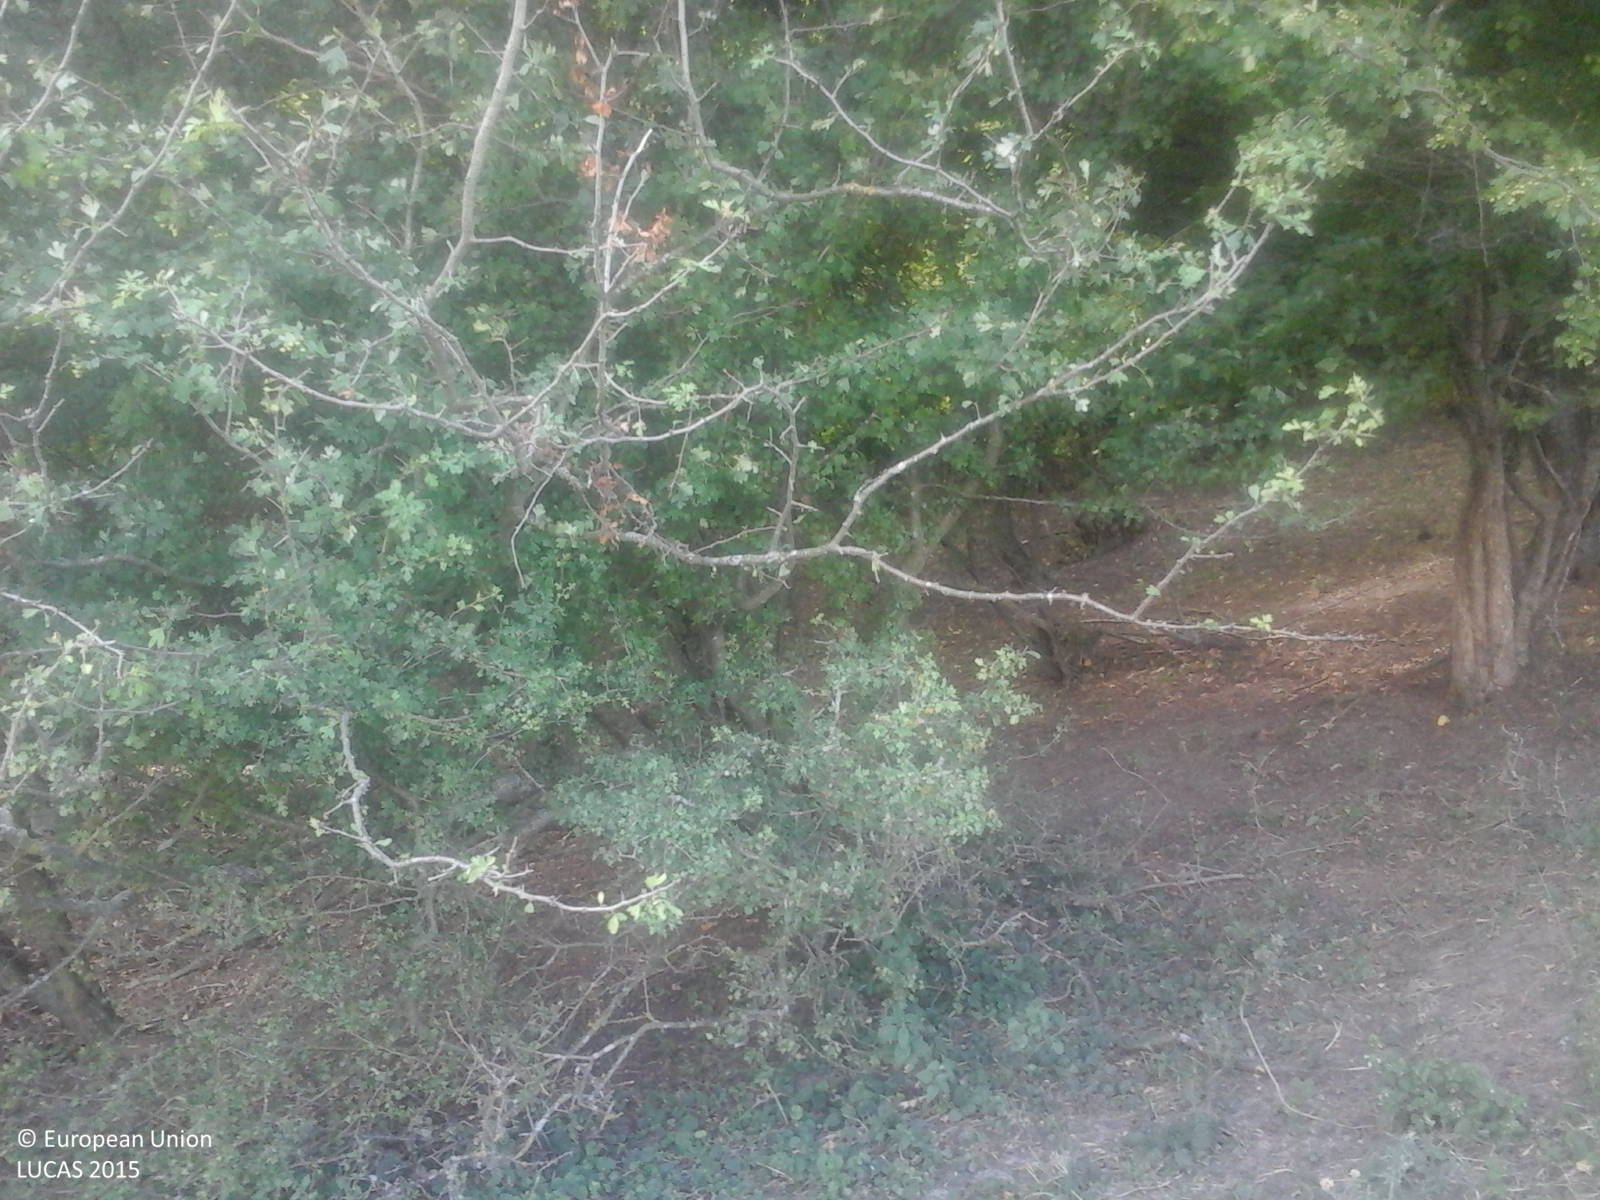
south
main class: Grassland
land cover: Grassland with sparse tree/shrub cover
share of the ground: > 75 %
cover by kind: herbaceous plants 85 %, shrubs 10 %, broadleaved forest trees 5 %
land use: Agriculture (excluding fallow land and kitchen gardens)
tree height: < 5 m
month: July
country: RO
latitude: 46.6053
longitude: 27.9462
